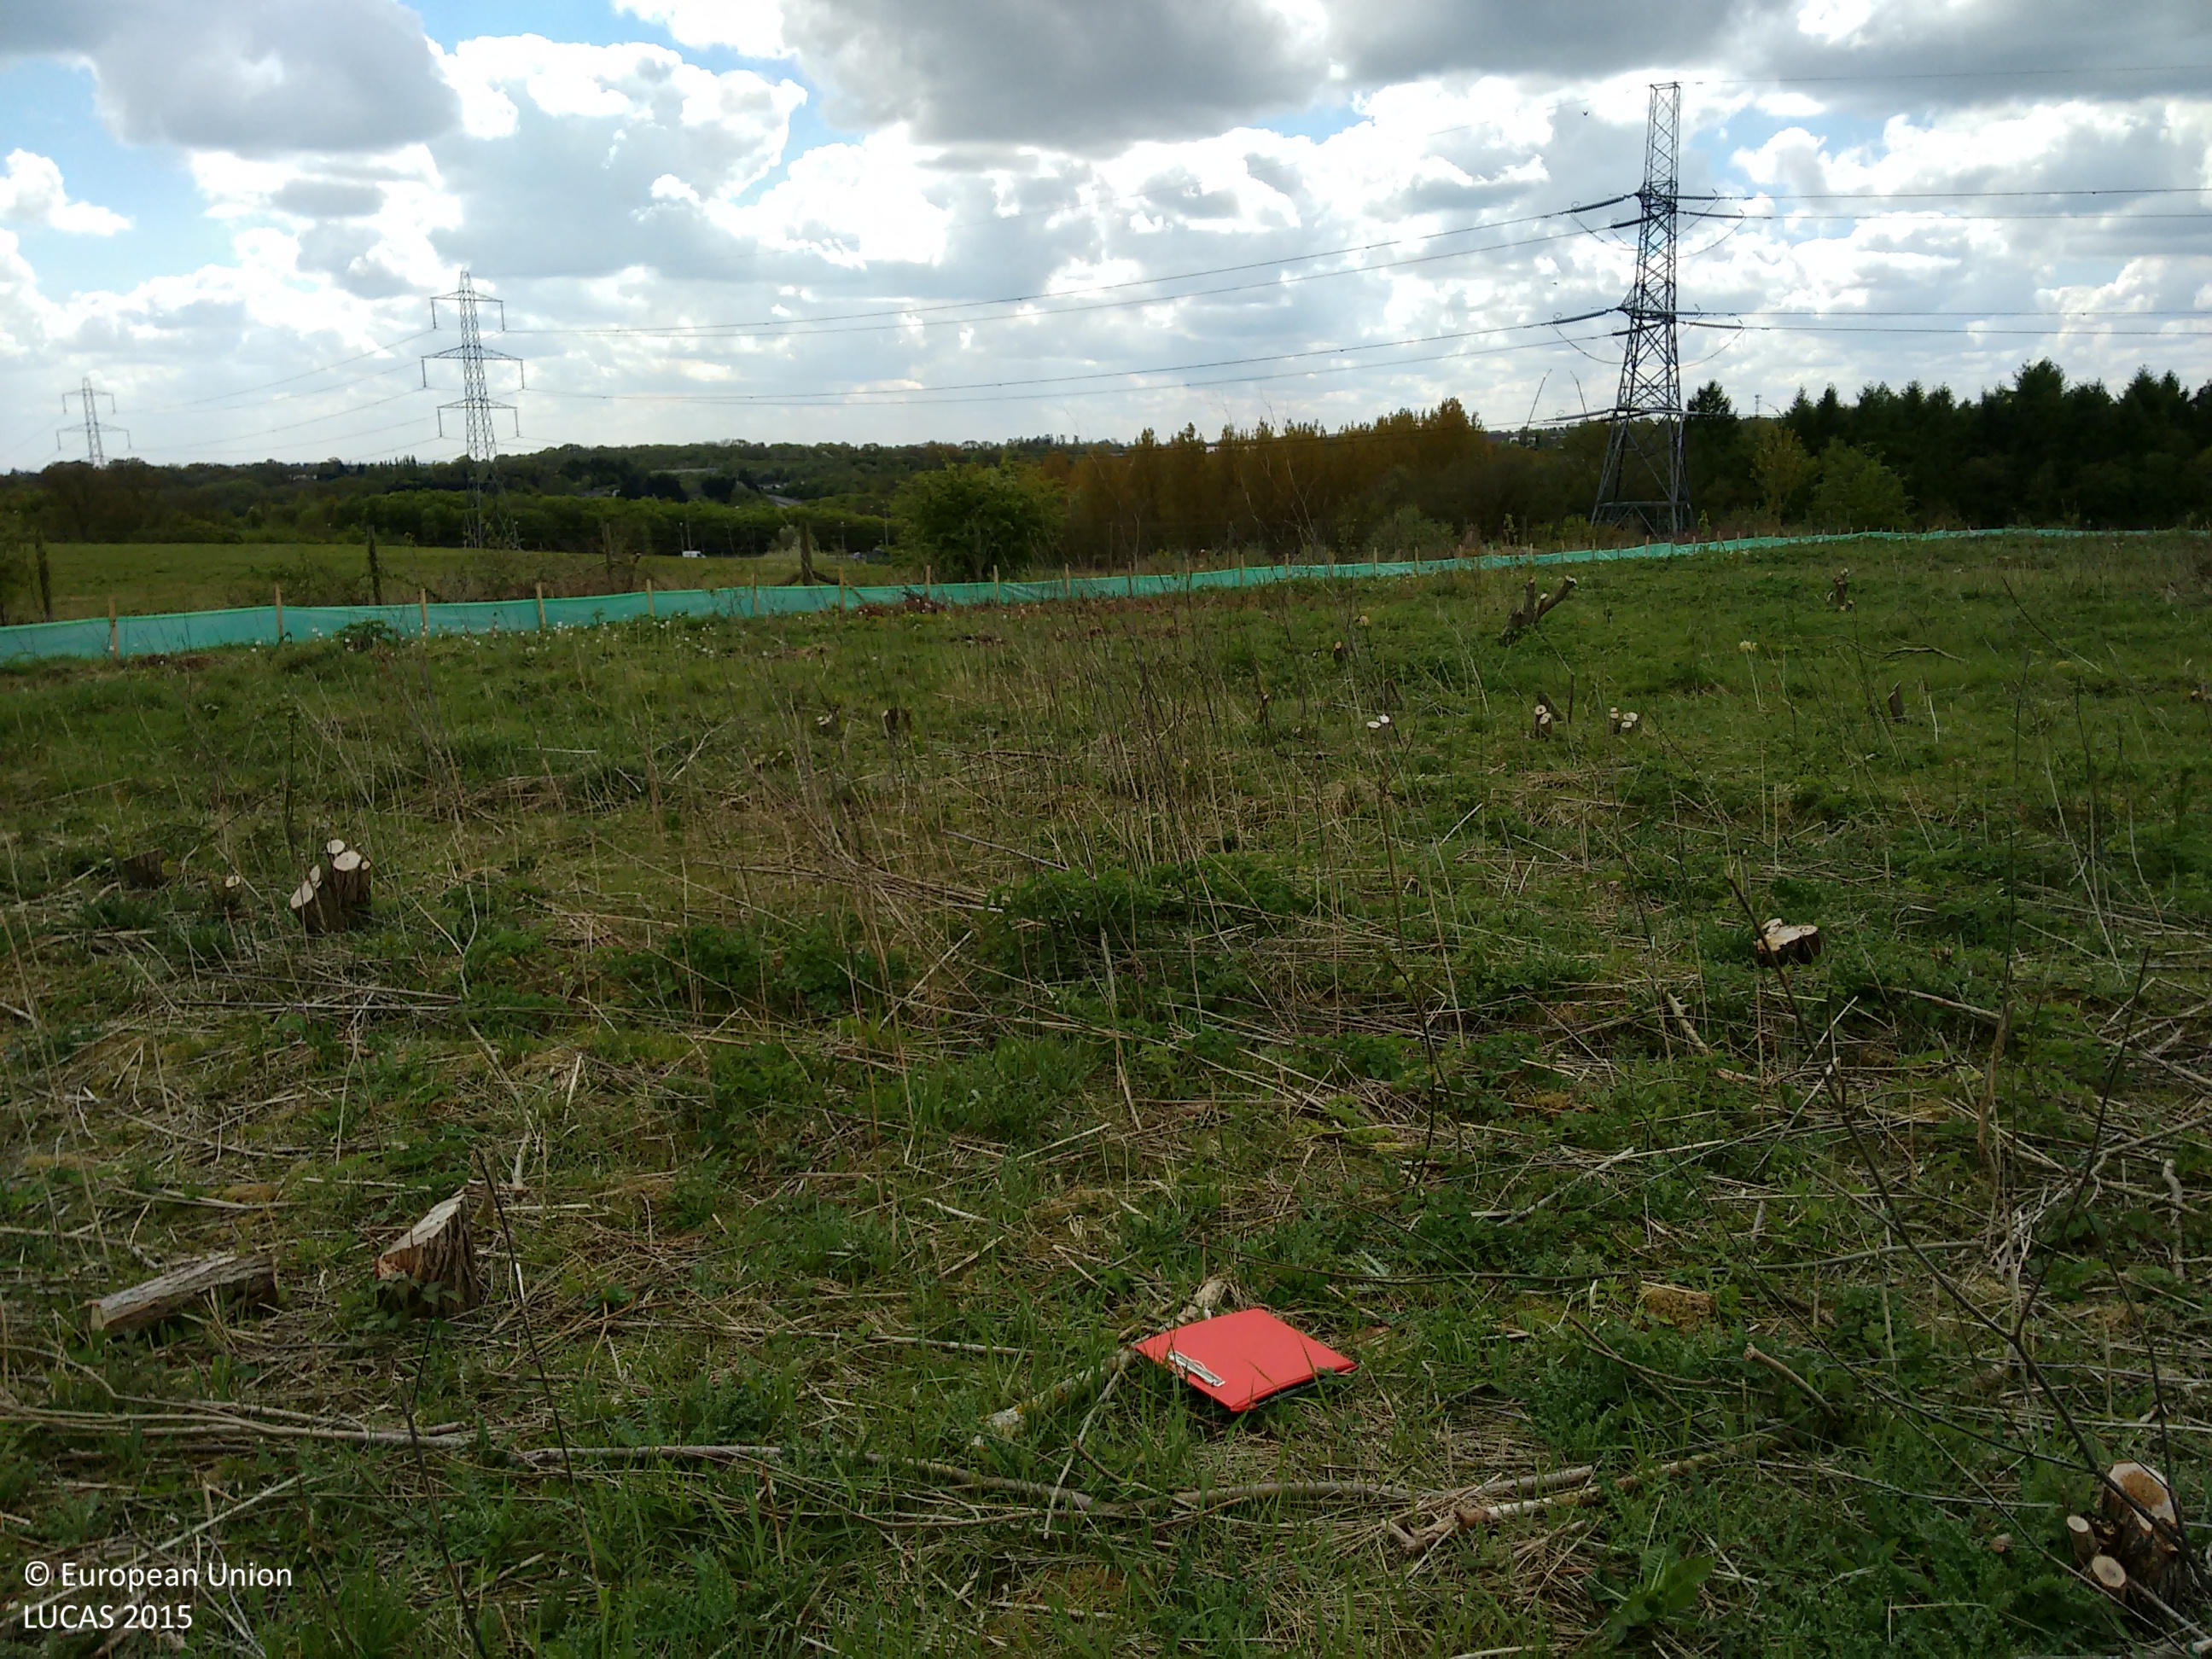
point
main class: Grassland
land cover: Grassland without tree/shrub cover
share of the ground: > 75 %
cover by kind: herbaceous plants 100 %
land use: Agriculture (excluding fallow land and kitchen gardens)
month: April
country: GB
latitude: 51.5636
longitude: -0.5261
